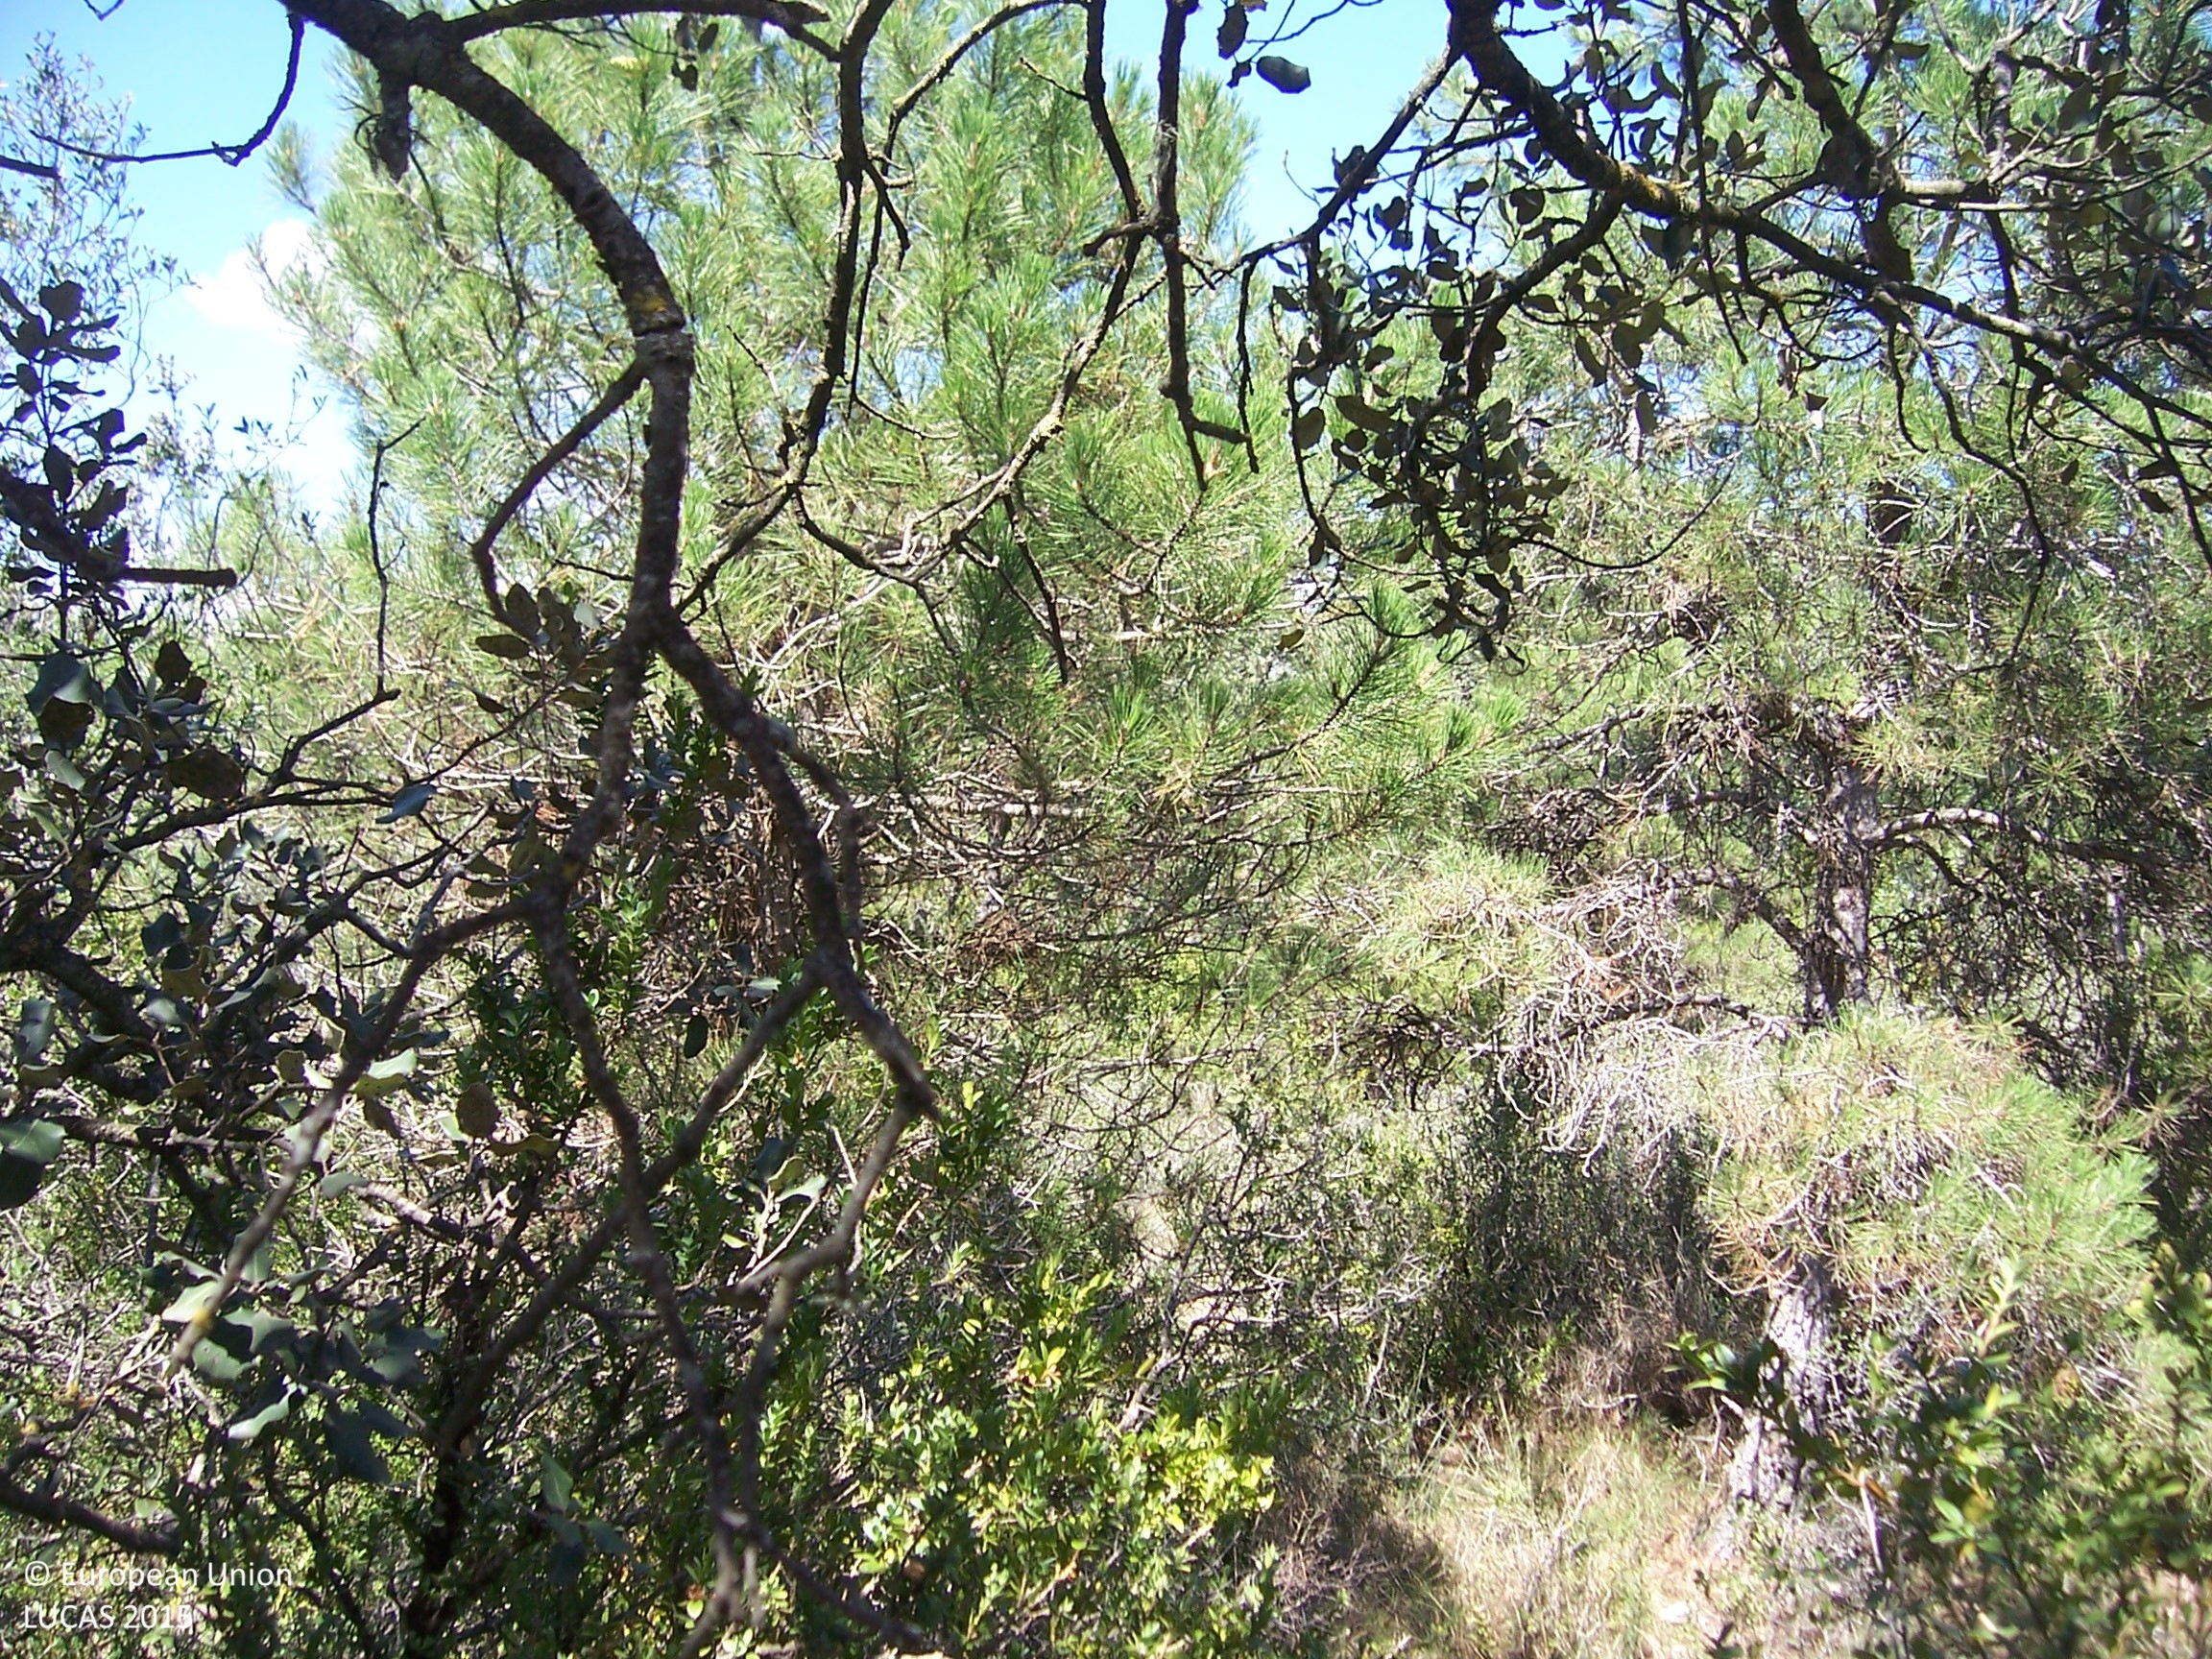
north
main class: Woodland
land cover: Pine dominated mixed woodland
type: coniferous forest of the mediterranean region
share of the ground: > 75 %
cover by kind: coniferous forest trees 40 %, broadleaved forest trees 30 %, shrubs 20 %, herbaceous plants 10 %
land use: Semi-natural and natural areas not in use
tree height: > 5 m
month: August
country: ES
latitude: 41.9580
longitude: 0.5621
